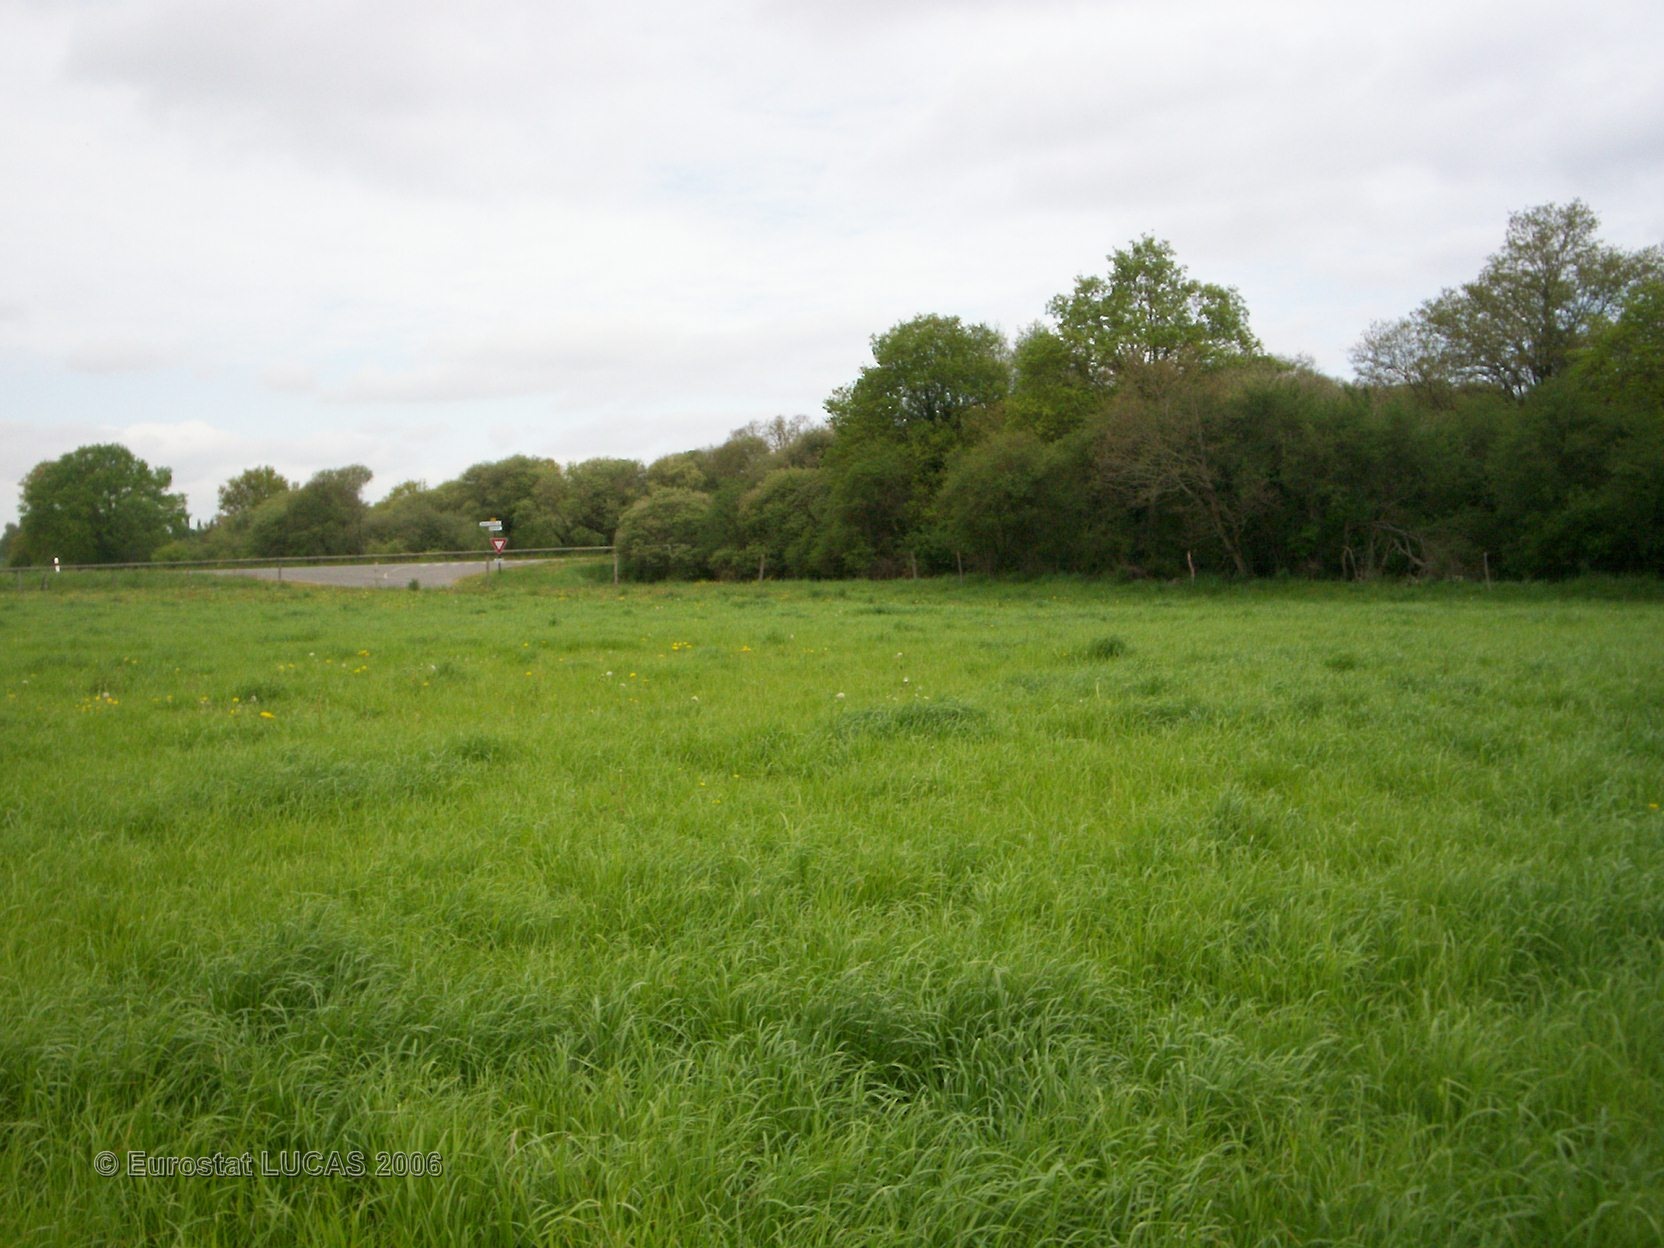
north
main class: Grassland
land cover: Grassland without tree/shrub cover
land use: Agriculture (excluding fallow land and kitchen gardens)
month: May
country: FR
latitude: 47.8248
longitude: -1.2752
